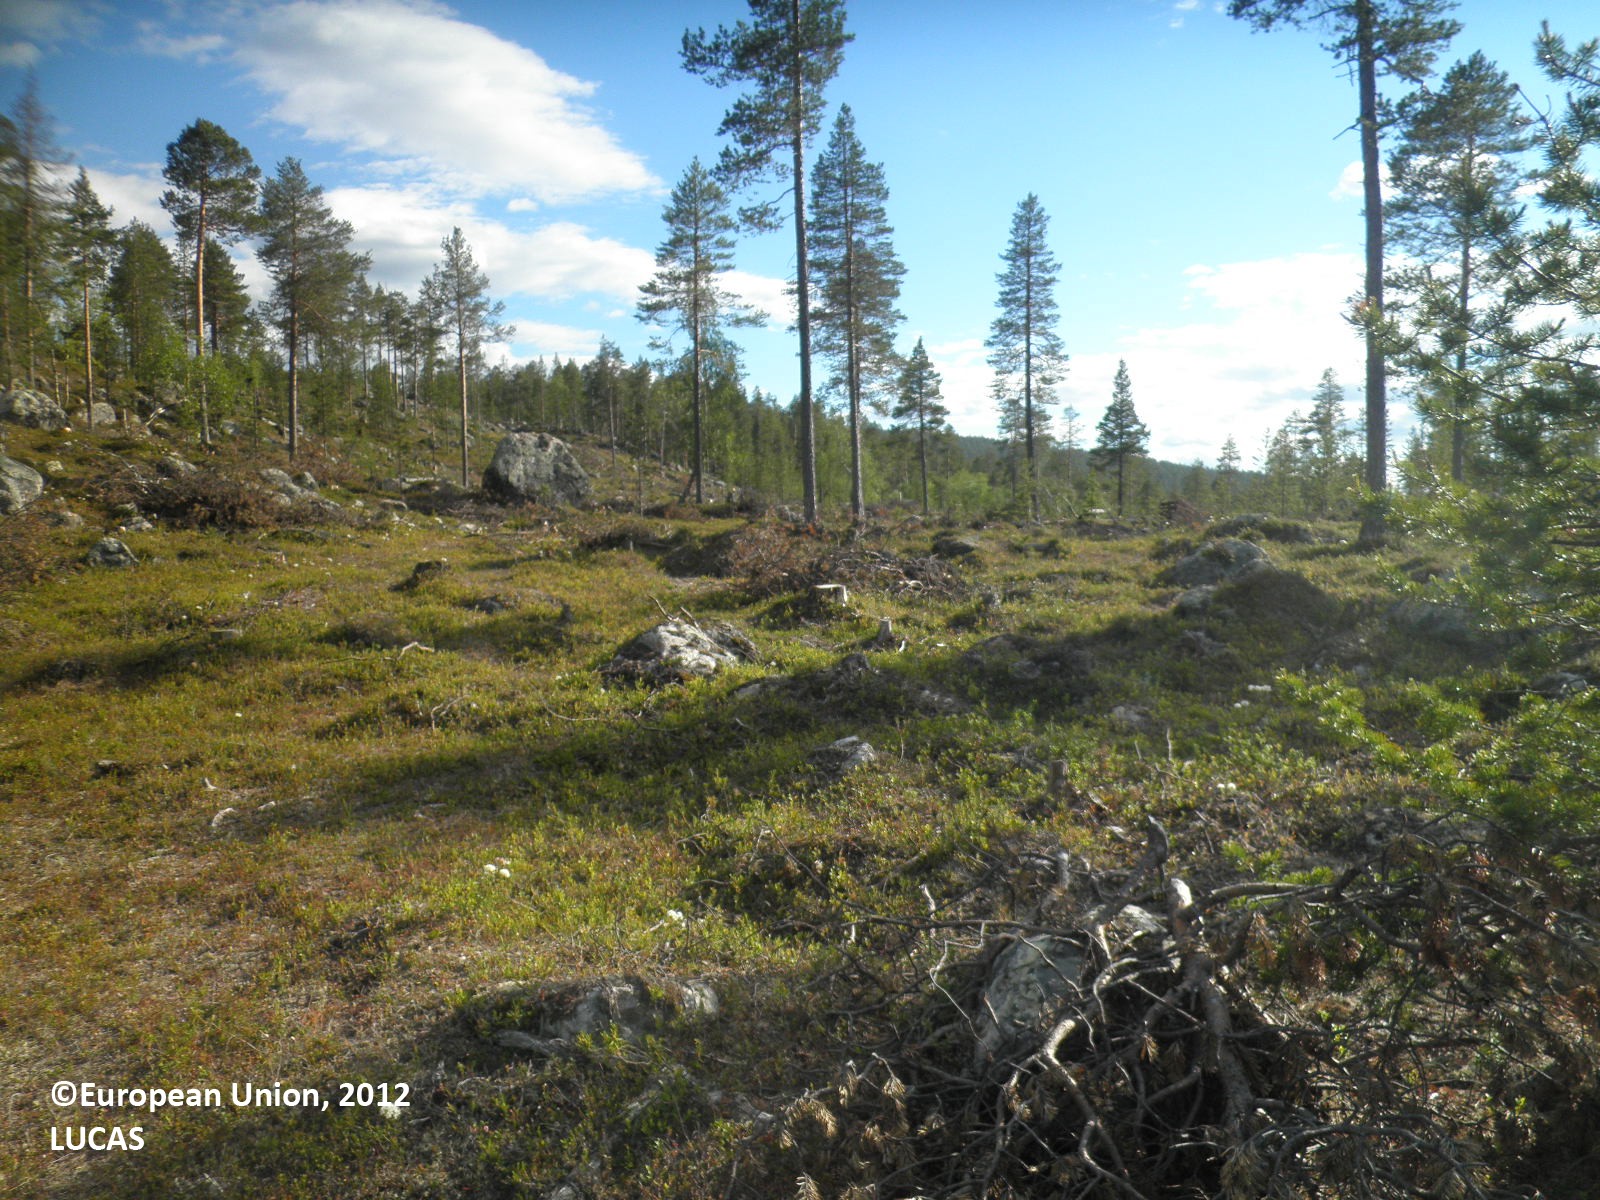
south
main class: Woodland
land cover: Pine dominated coniferous woodland
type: boreal forest
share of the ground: 10 - 25 %
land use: Forestry
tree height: > 5 m
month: July
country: FI
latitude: 68.8843
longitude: 27.1003
